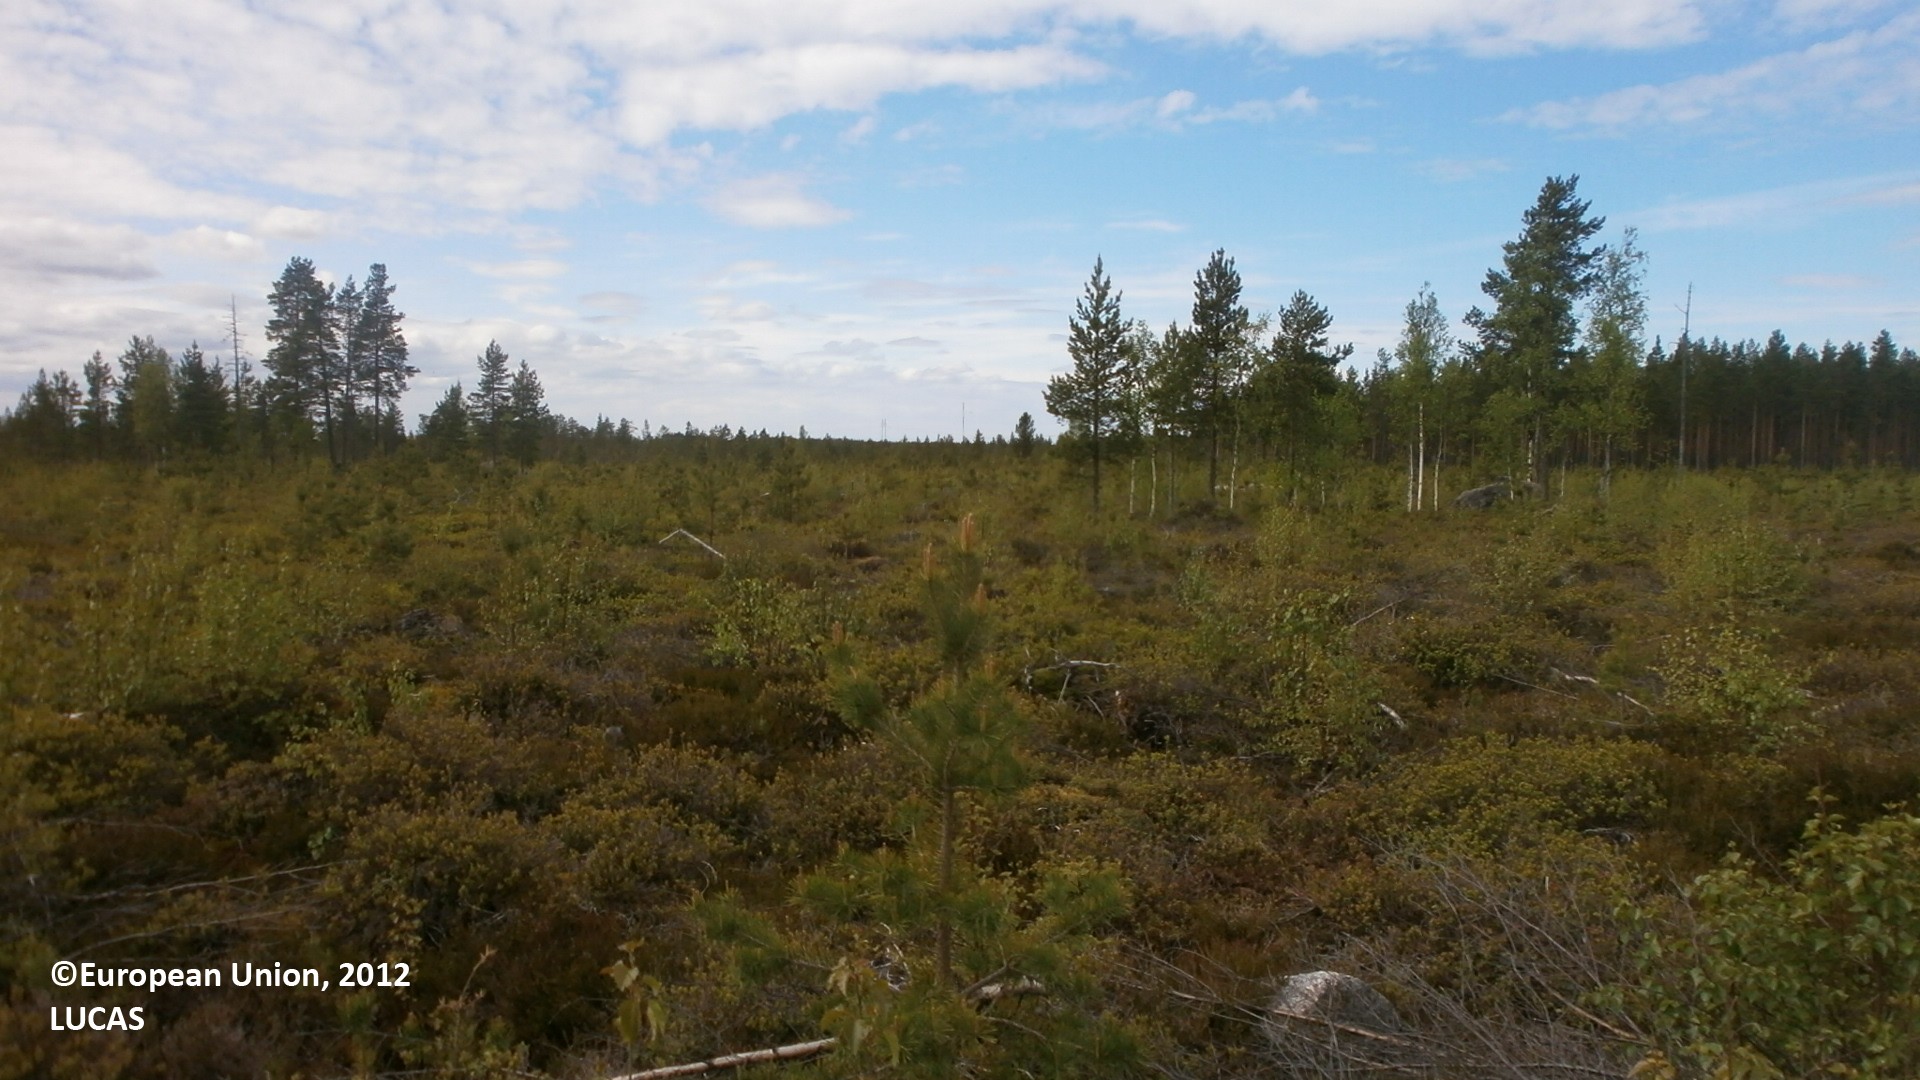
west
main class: Woodland
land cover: Other mixed woodland
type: hemiboreal forest and nemoral coniferous forest and mixed broadleaved-coniferous forest
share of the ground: 10 - 25 %
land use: Forestry
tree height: < 5 m
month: June
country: FI
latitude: 64.4701
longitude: 25.0323
